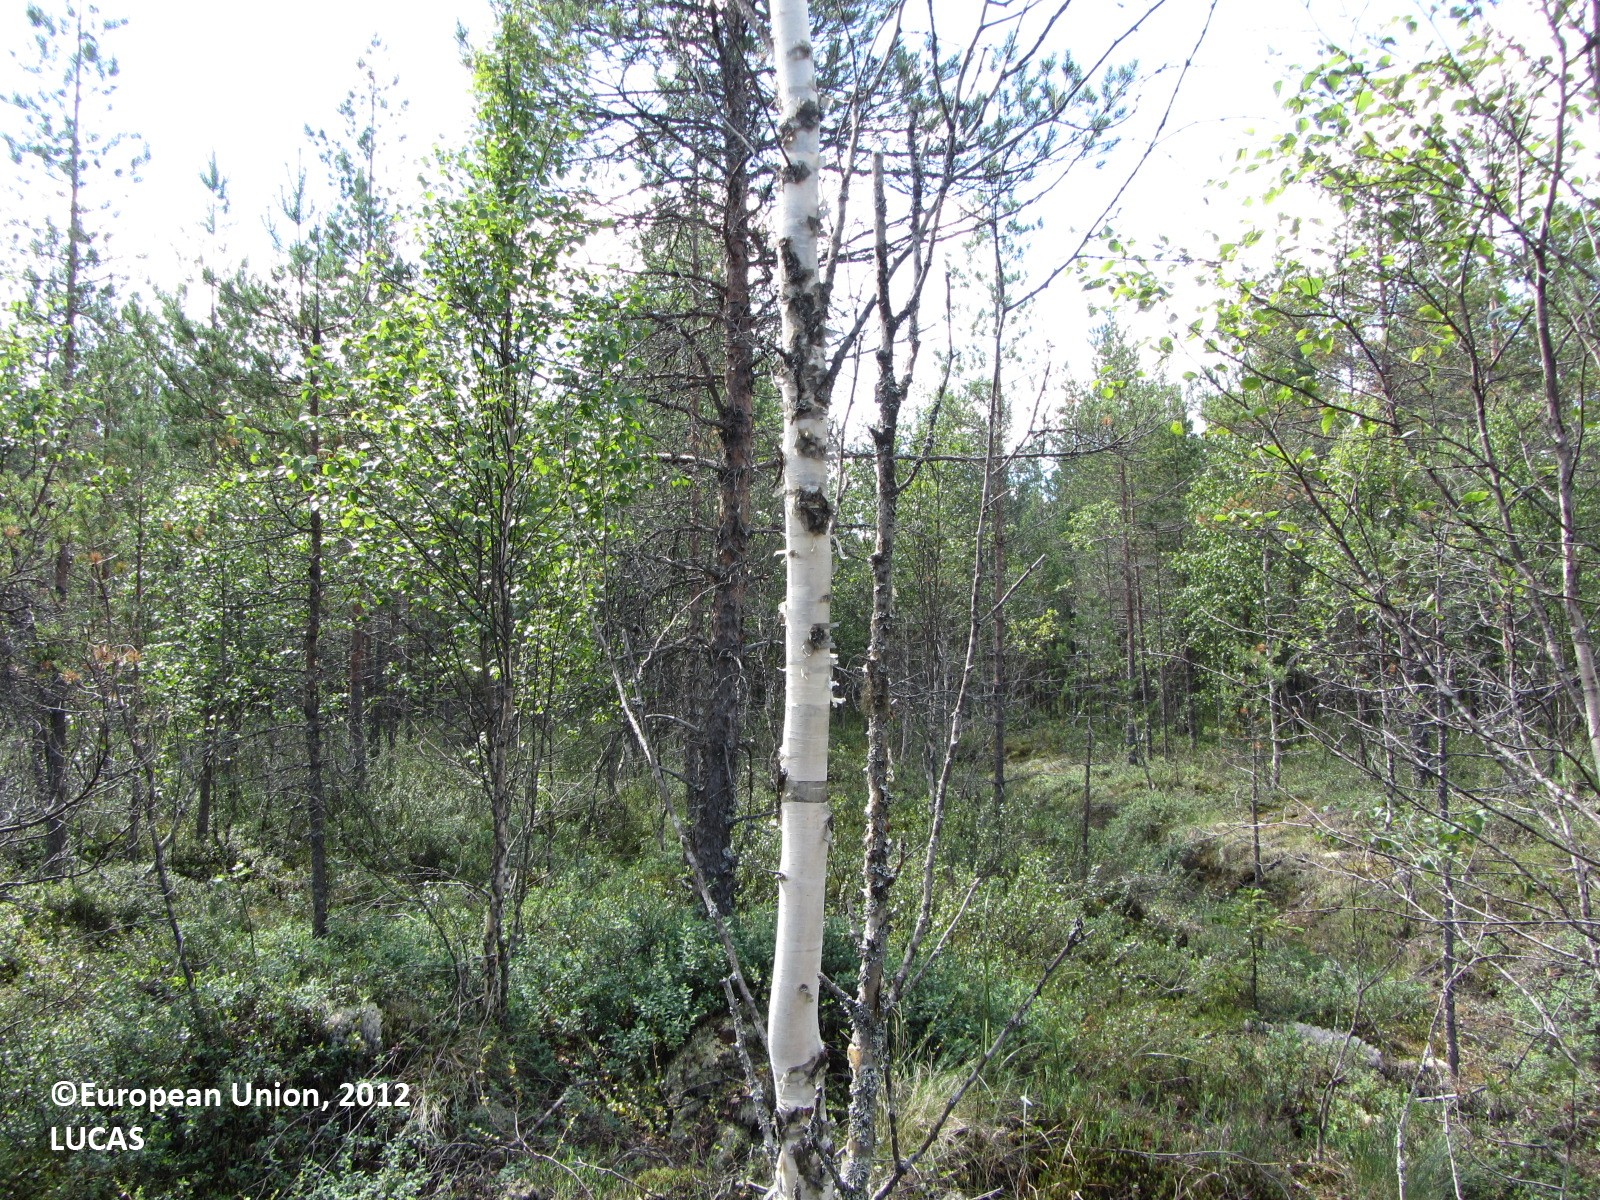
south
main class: Woodland
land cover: Pine dominated coniferous woodland
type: boreal forest
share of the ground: 50 - 75 %
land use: Forestry
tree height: > 5 m
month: July
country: FI
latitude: 63.6866
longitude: 25.4863
